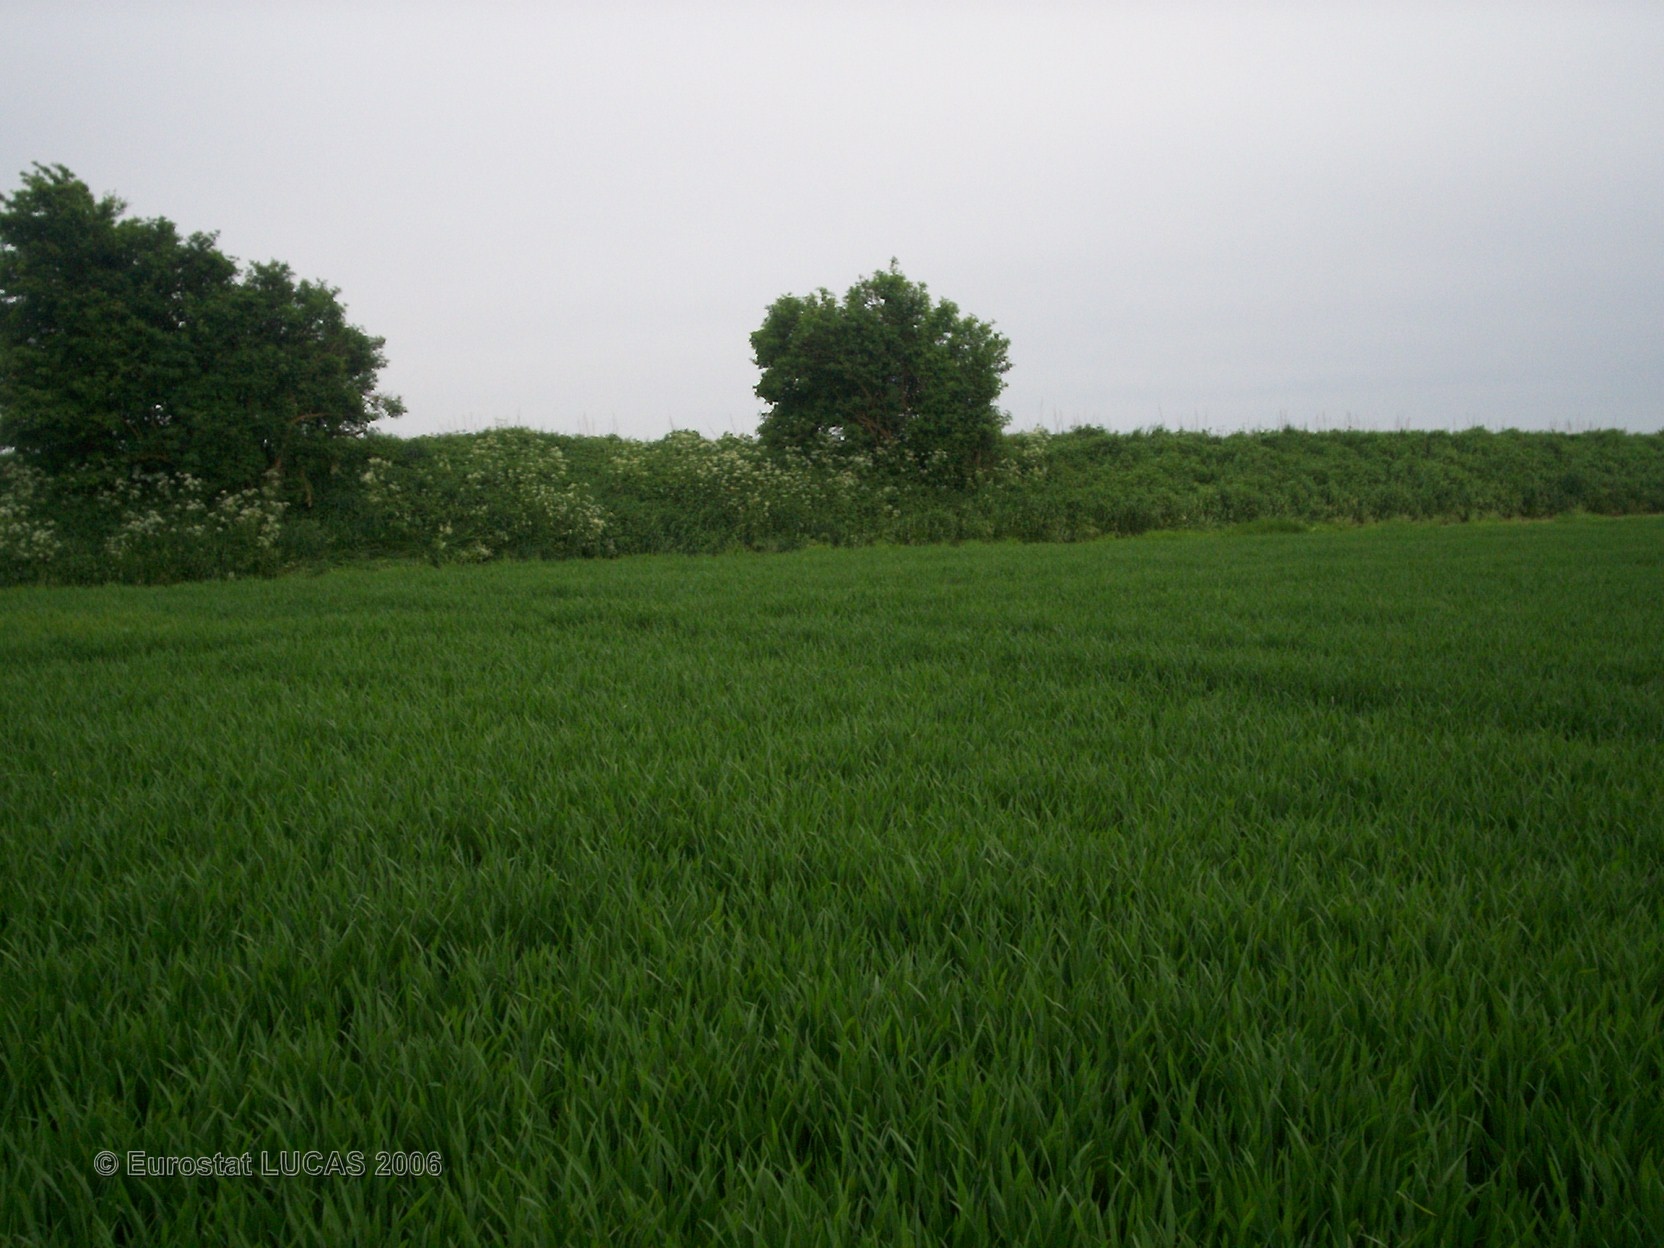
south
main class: Cropland
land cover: Common wheat
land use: Agriculture (excluding fallow land and kitchen gardens)
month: May
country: FR
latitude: 50.2719
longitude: 2.6502
